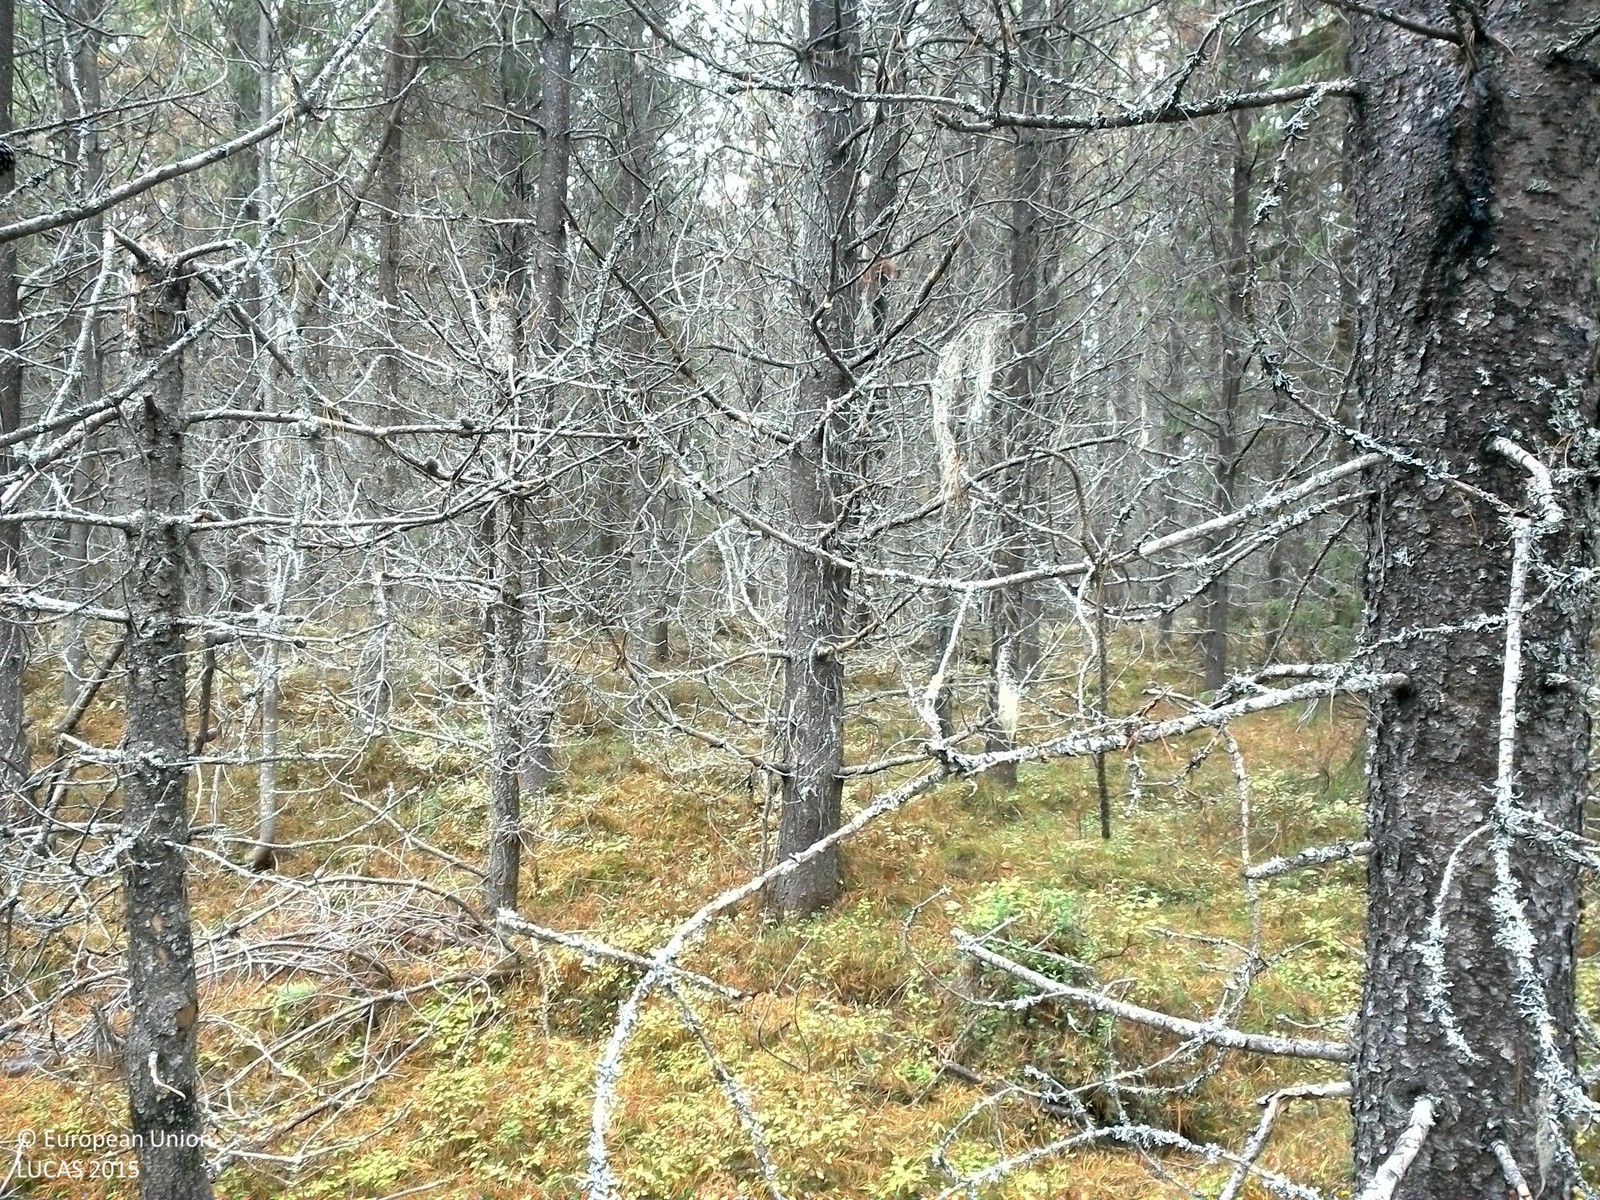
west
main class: Woodland
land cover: Pine dominated coniferous woodland
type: exotic forest
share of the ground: 50 - 75 %
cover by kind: coniferous forest trees 60 %, lichens and mosses 20 %, shrubs 10 %, herbaceous plants 10 %
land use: Forestry
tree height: > 5 m
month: October
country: SE
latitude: 64.1057
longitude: 15.9434
